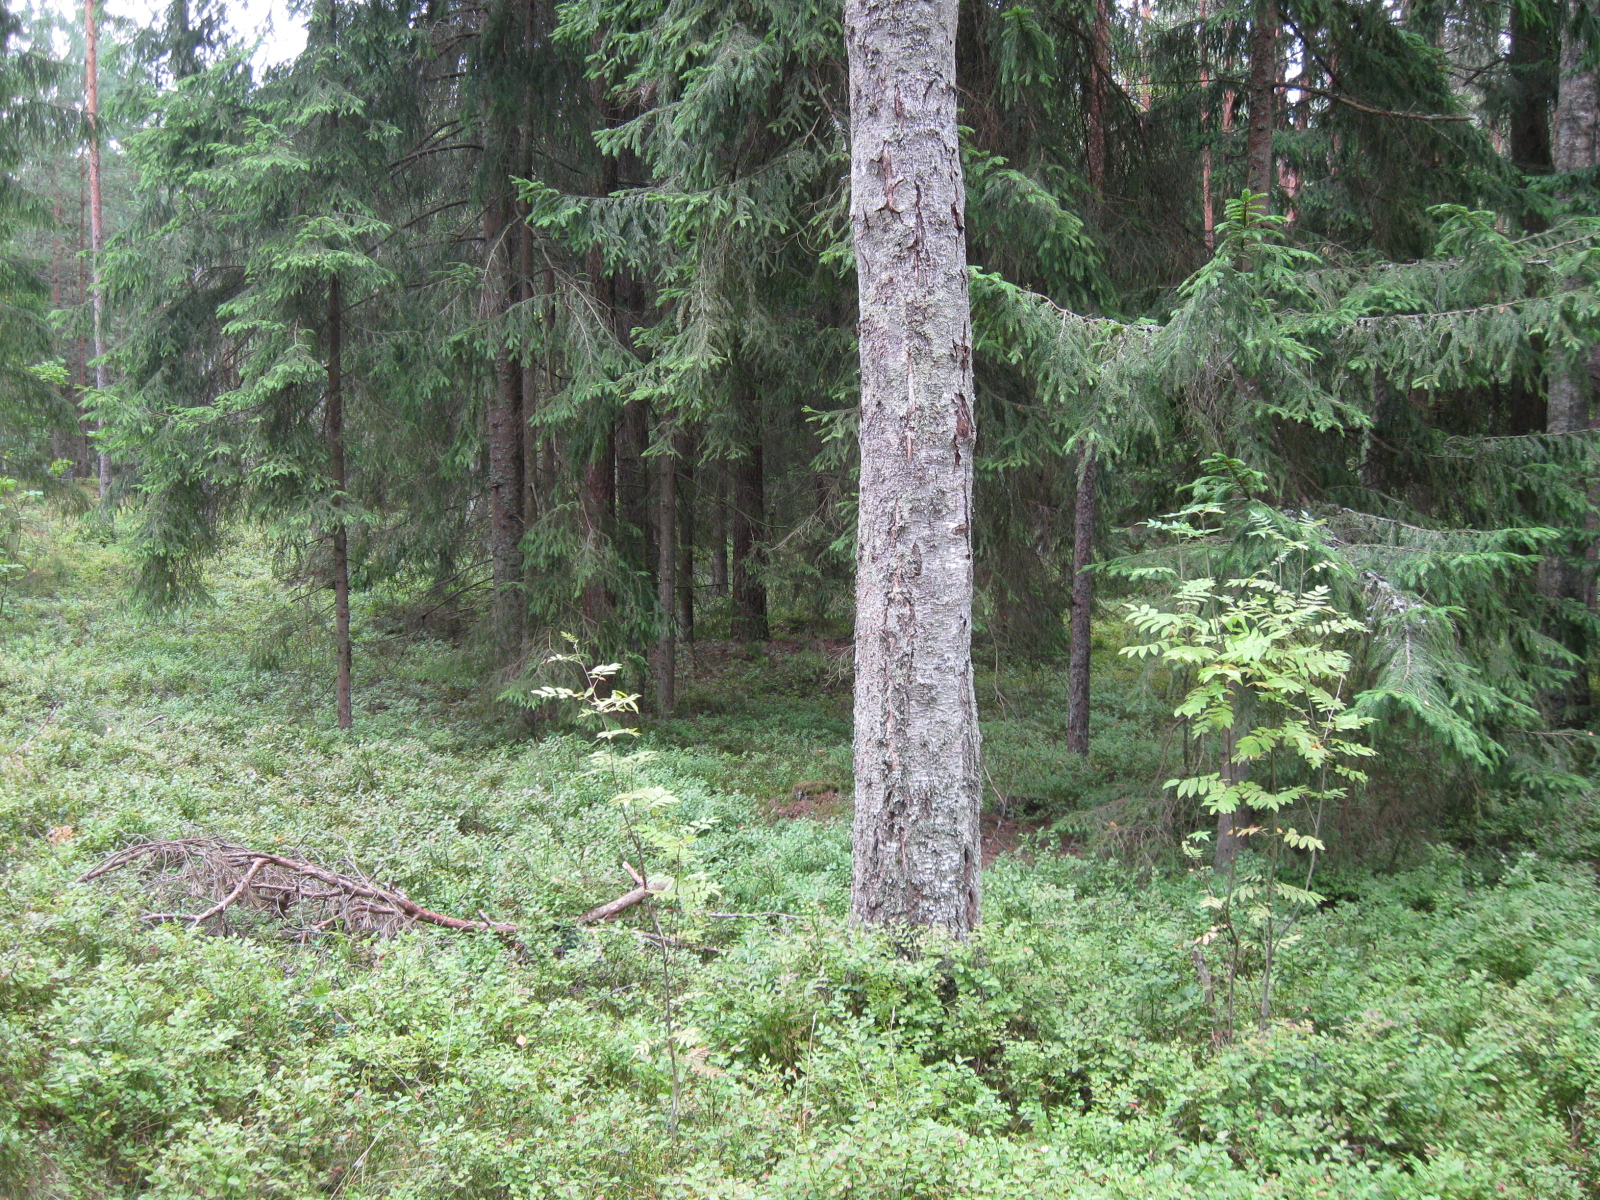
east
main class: Woodland
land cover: Pine dominated mixed woodland
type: hemiboreal forest and nemoral coniferous forest and mixed broadleaved-coniferous forest
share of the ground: > 75 %
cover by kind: coniferous forest trees 50 %, broadleaved forest trees 30 %, shrubs 10 %, herbaceous plants 5 %, lichens and mosses 5 %
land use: Forestry
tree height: > 5 m
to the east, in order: Tracks; Pine dominated mixed woodland; Tracks; Pine dominated mixed woodland; Tracks; Pine dominated mixed woodland; Broadleaved woodland
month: July
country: LT
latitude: 54.8544
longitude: 23.6194
